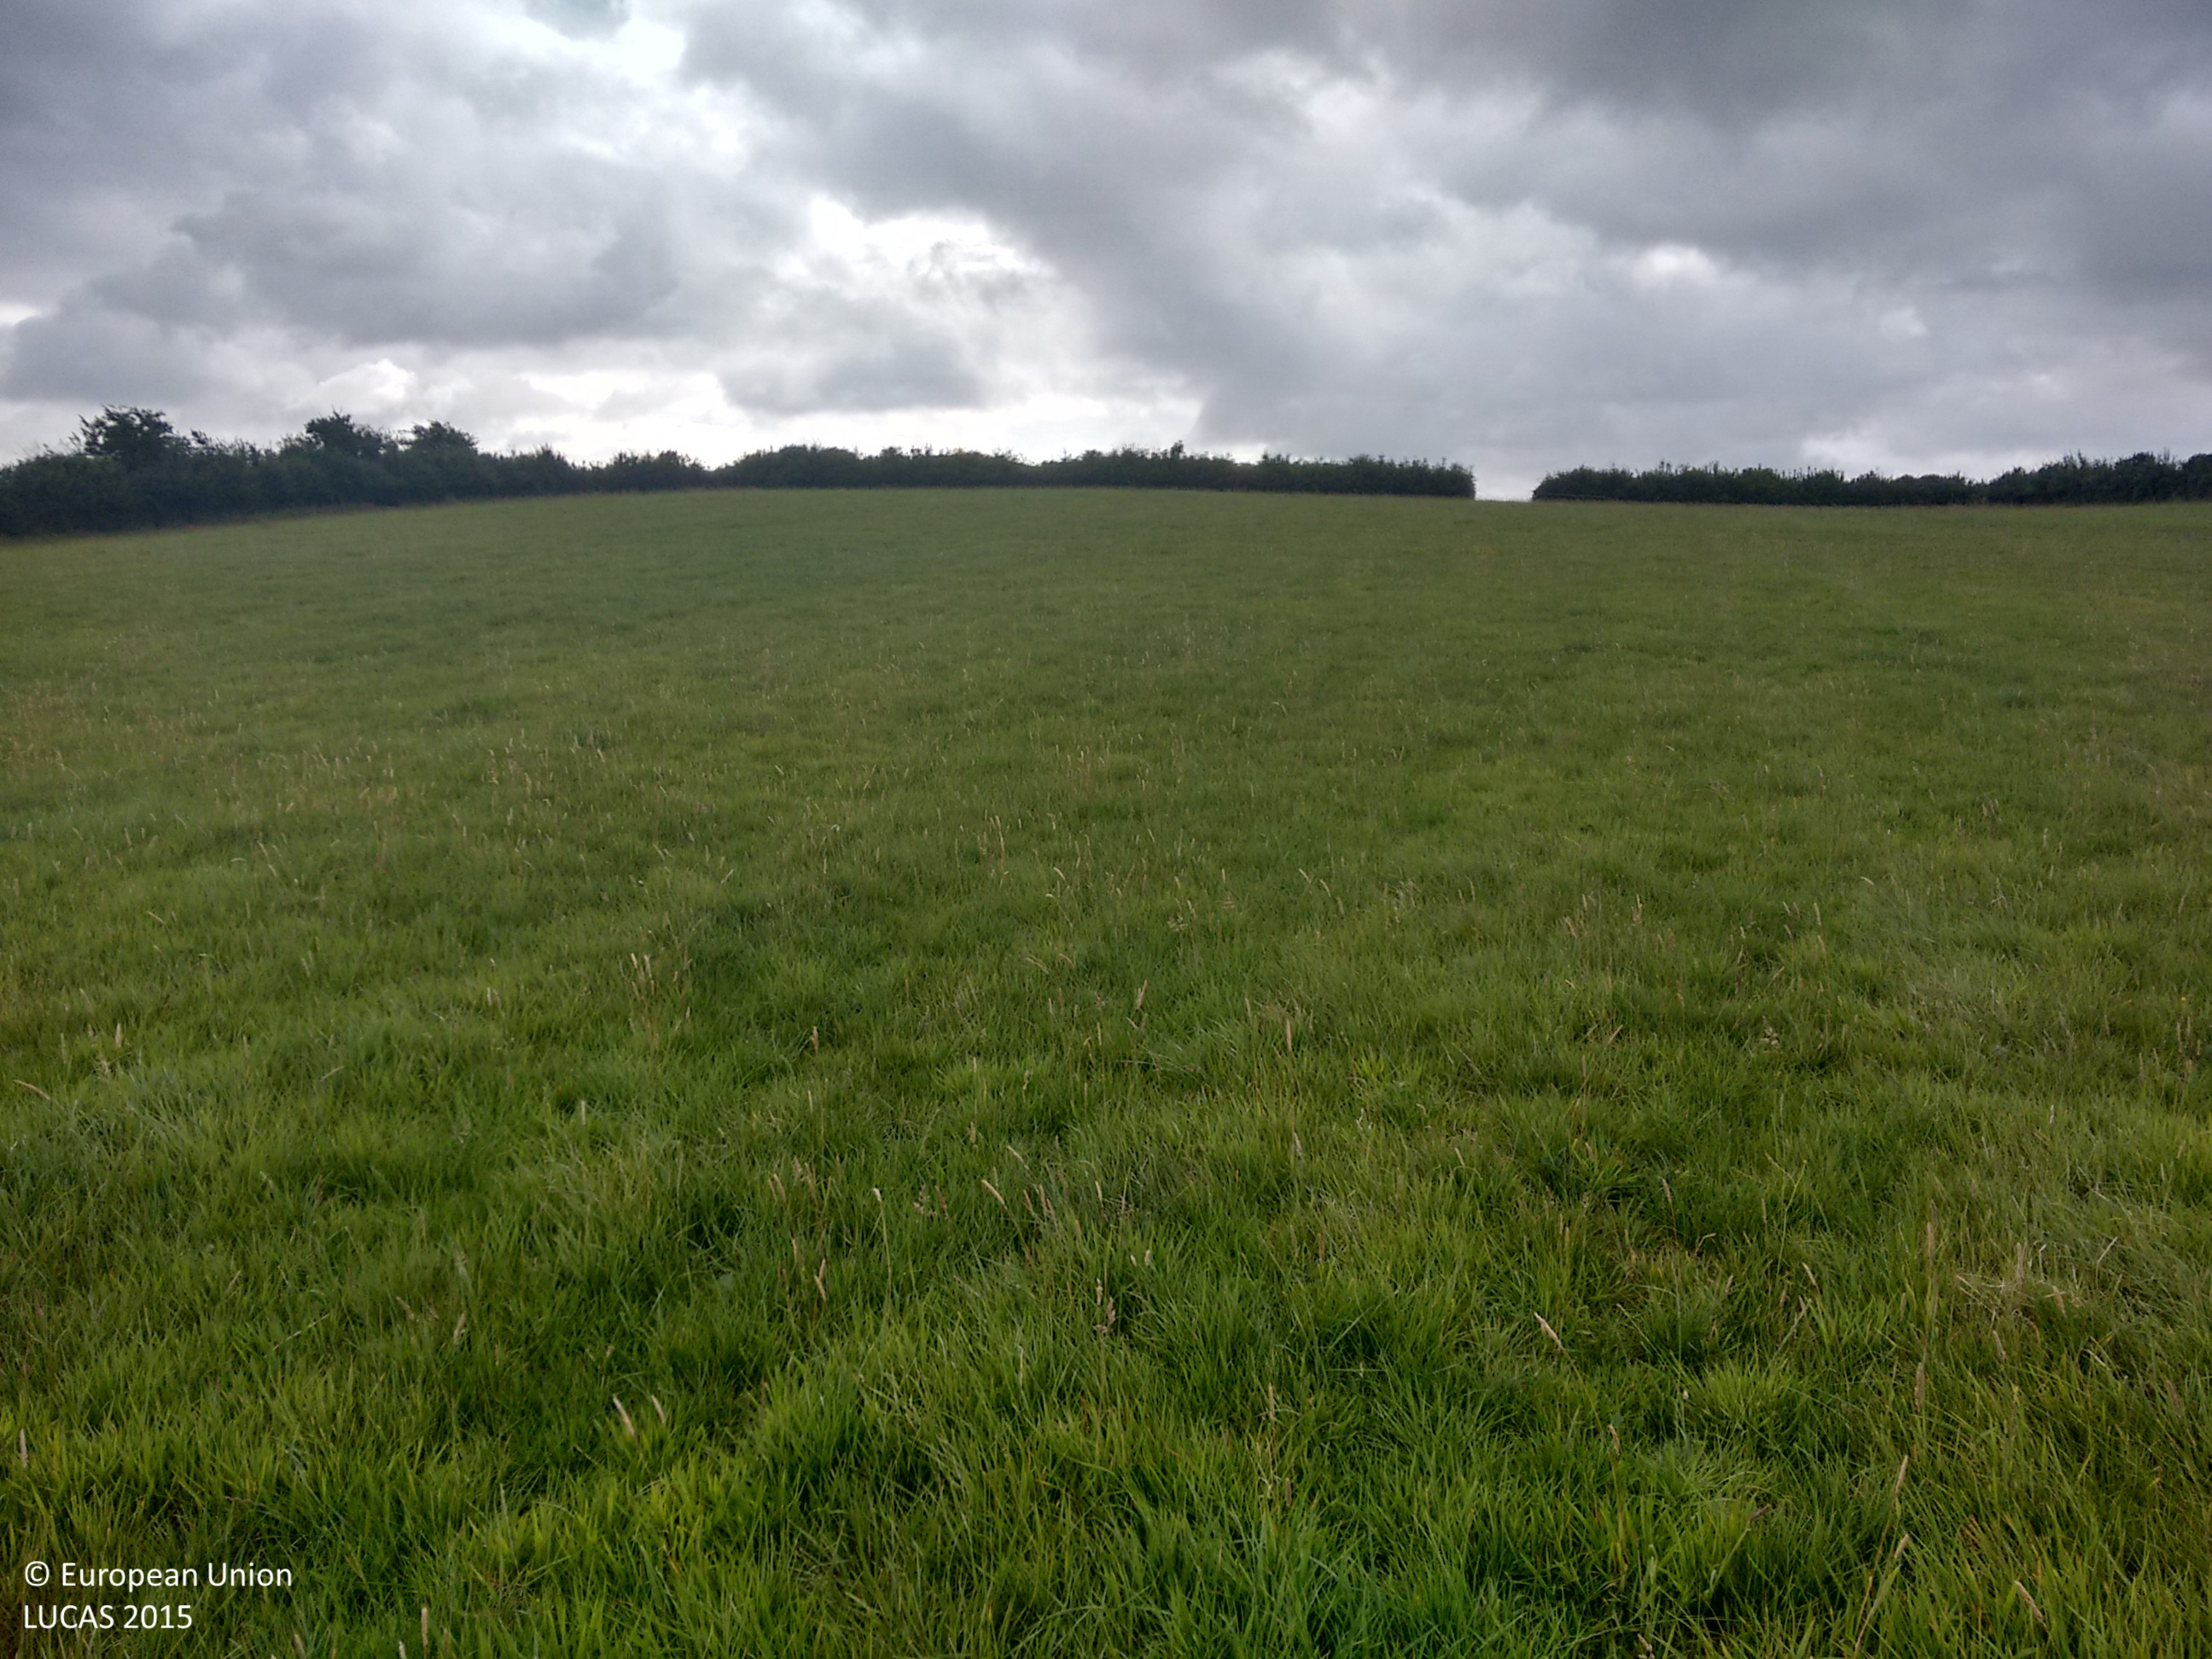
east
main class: Grassland
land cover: Grassland without tree/shrub cover
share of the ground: > 75 %
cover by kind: herbaceous plants 100 %
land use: Agriculture (excluding fallow land and kitchen gardens)
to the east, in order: Grassland without tree/shrub cover; Managed hedges; Grassland without tree/shrub cover
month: July
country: GB
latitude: 51.4808
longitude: -2.4638
